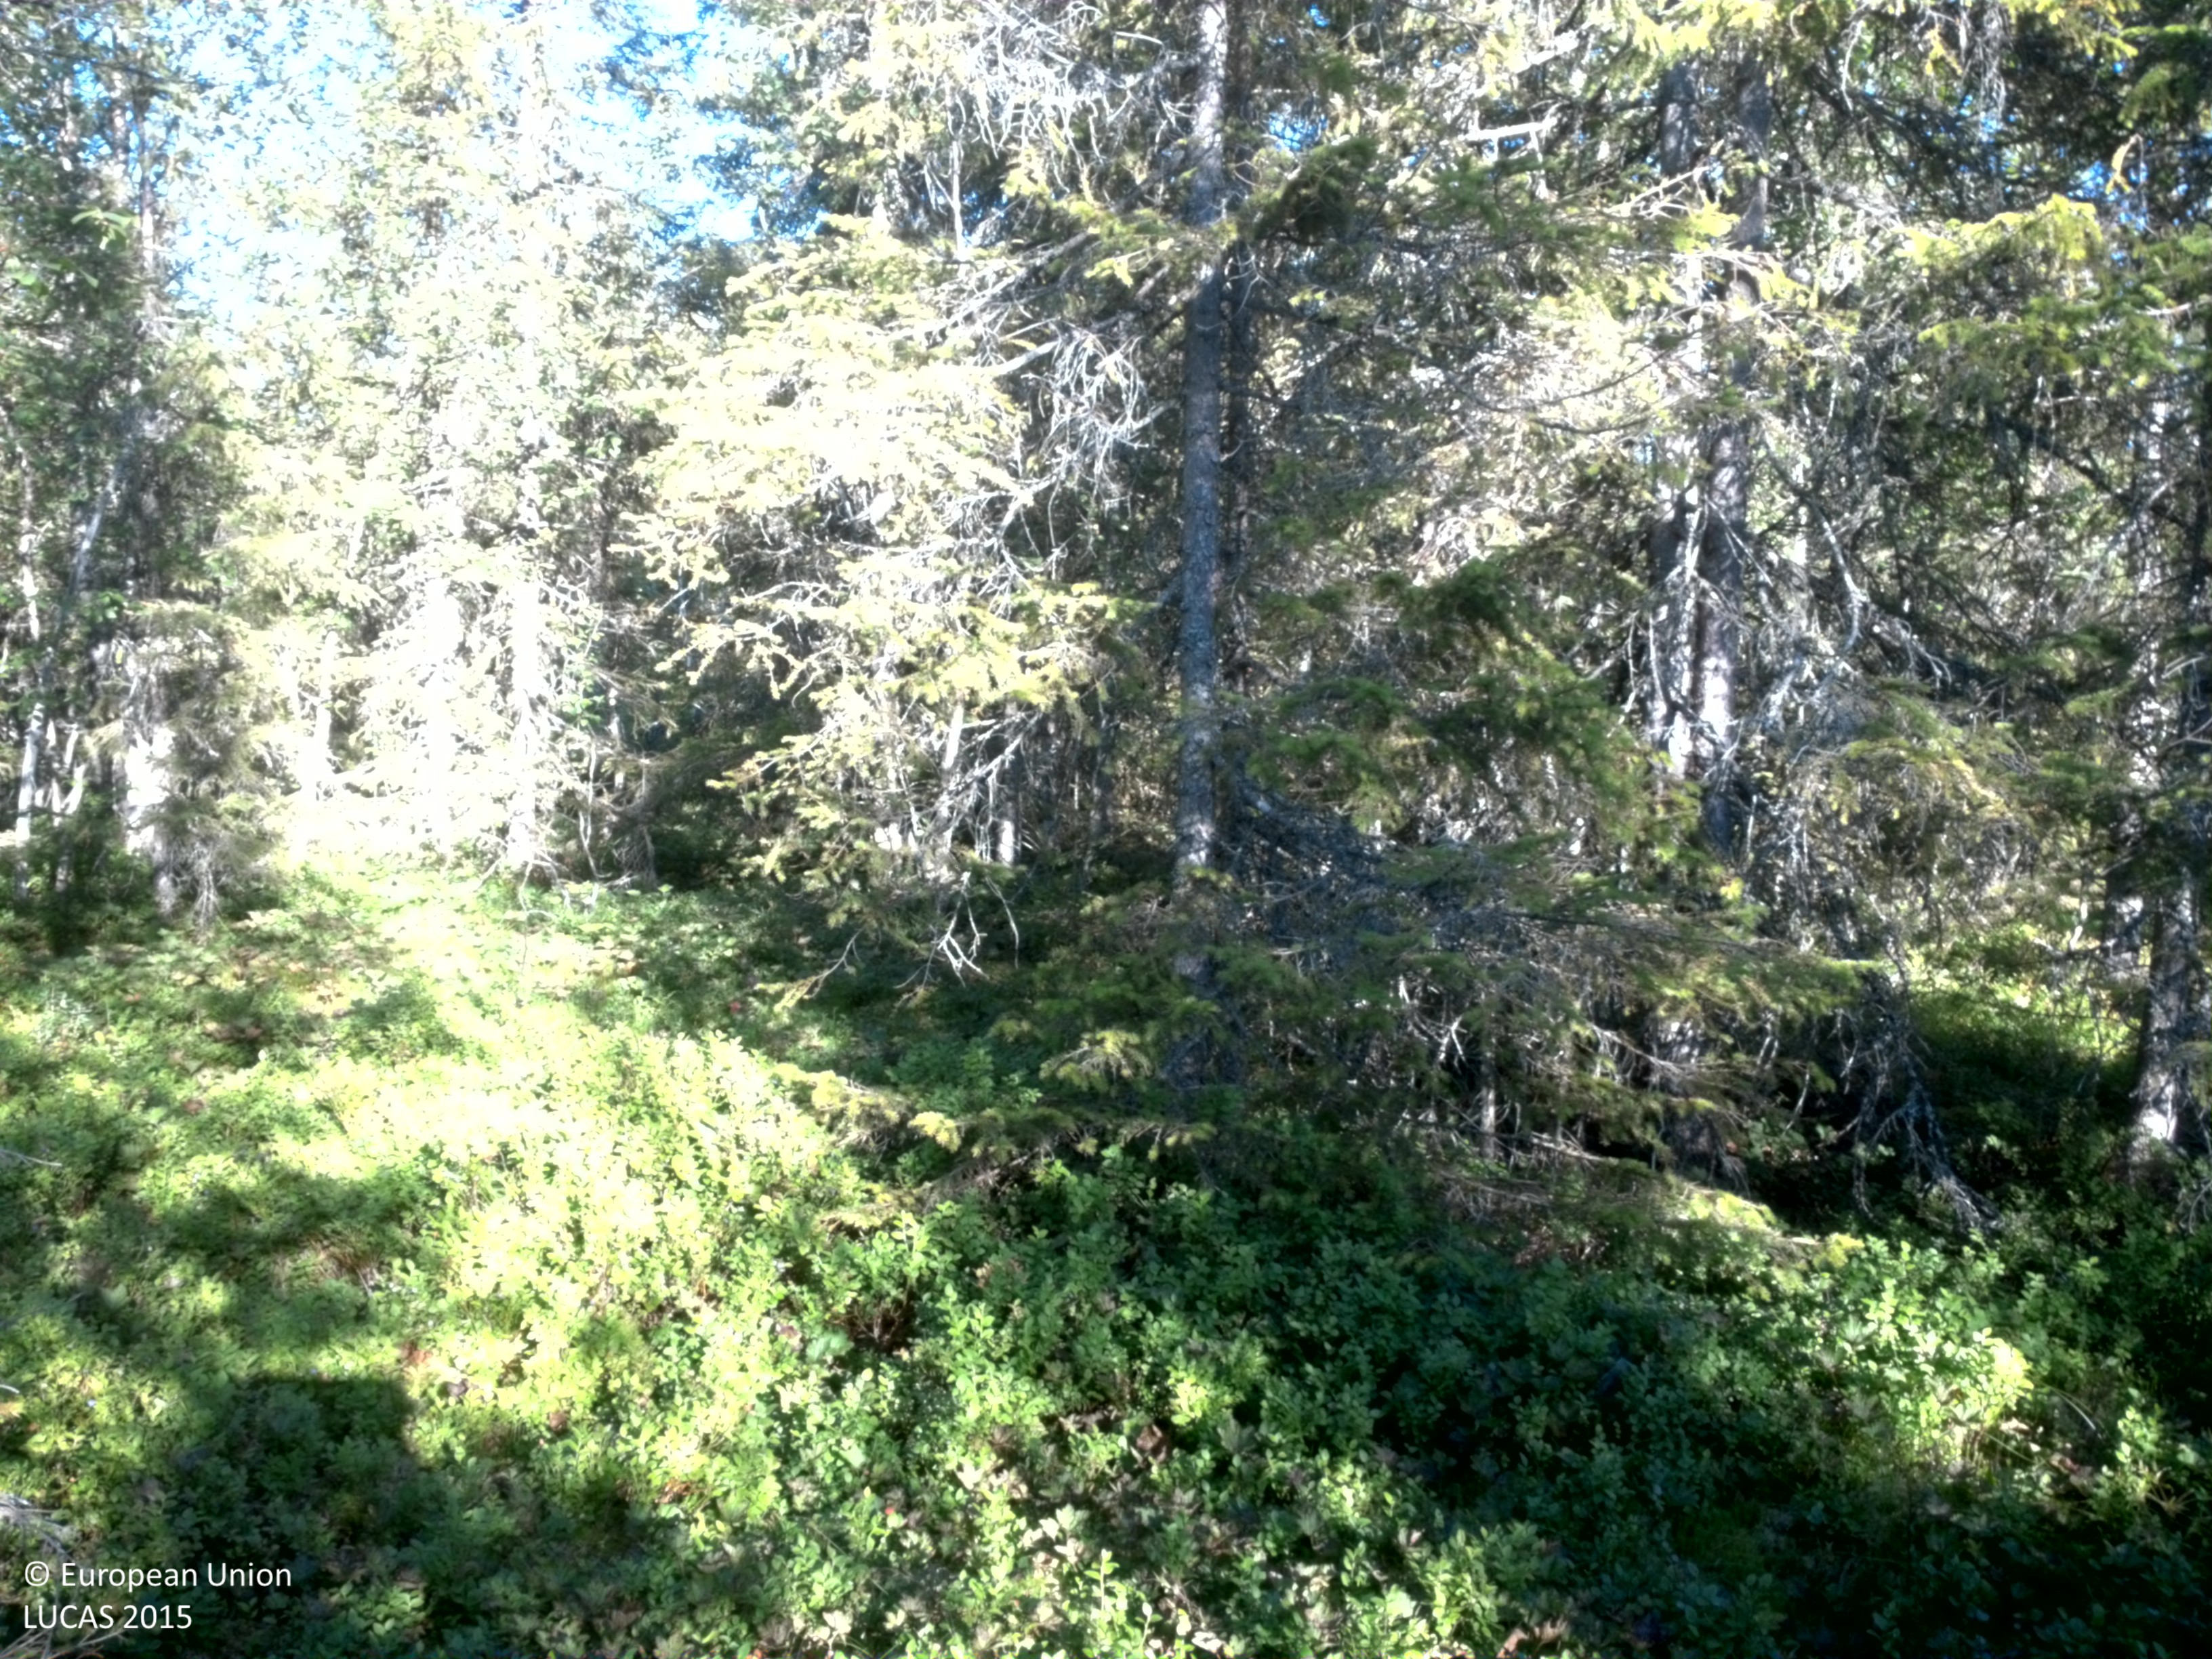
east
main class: Woodland
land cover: Spruce dominated mixed woodland
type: boreal forest
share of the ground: 50 - 75 %
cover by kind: coniferous forest trees 45 %, shrubs 30 %, broadleaved forest trees 15 %, herbaceous plants 5 %, lichens and mosses 5 %
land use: Forestry
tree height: > 5 m
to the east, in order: Spruce dominated mixed woodland; Ditches and canals; Spruce dominated mixed woodland; Pine dominated coniferous woodland; Spruce dominated mixed woodland; Ditches and canals; Tracks; Pine dominated coniferous woodland
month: August
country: SE
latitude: 64.4131
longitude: 18.3736
